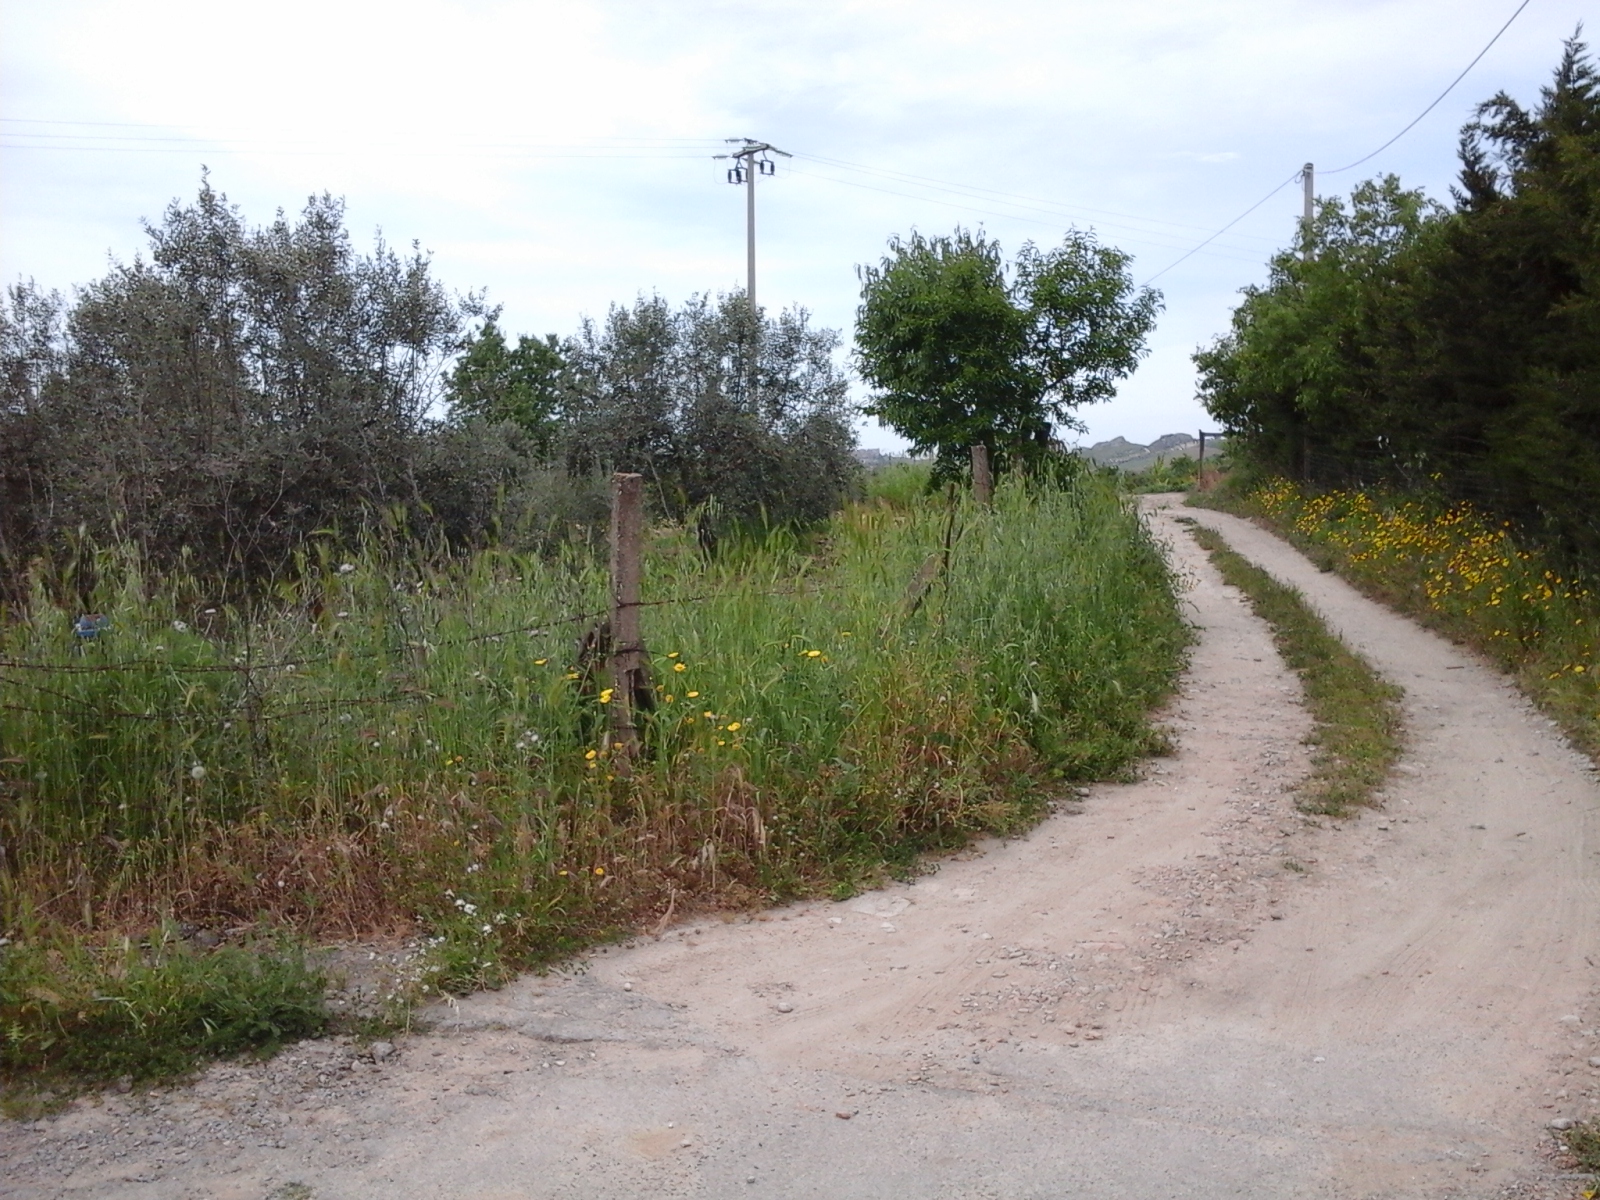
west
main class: Cropland
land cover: Olive groves
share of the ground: 50 - 75 %
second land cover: Other bare soil
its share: > 75 %
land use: Agriculture (excluding fallow land and kitchen gardens)
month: May
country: IT
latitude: 37.4192
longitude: 14.1831
